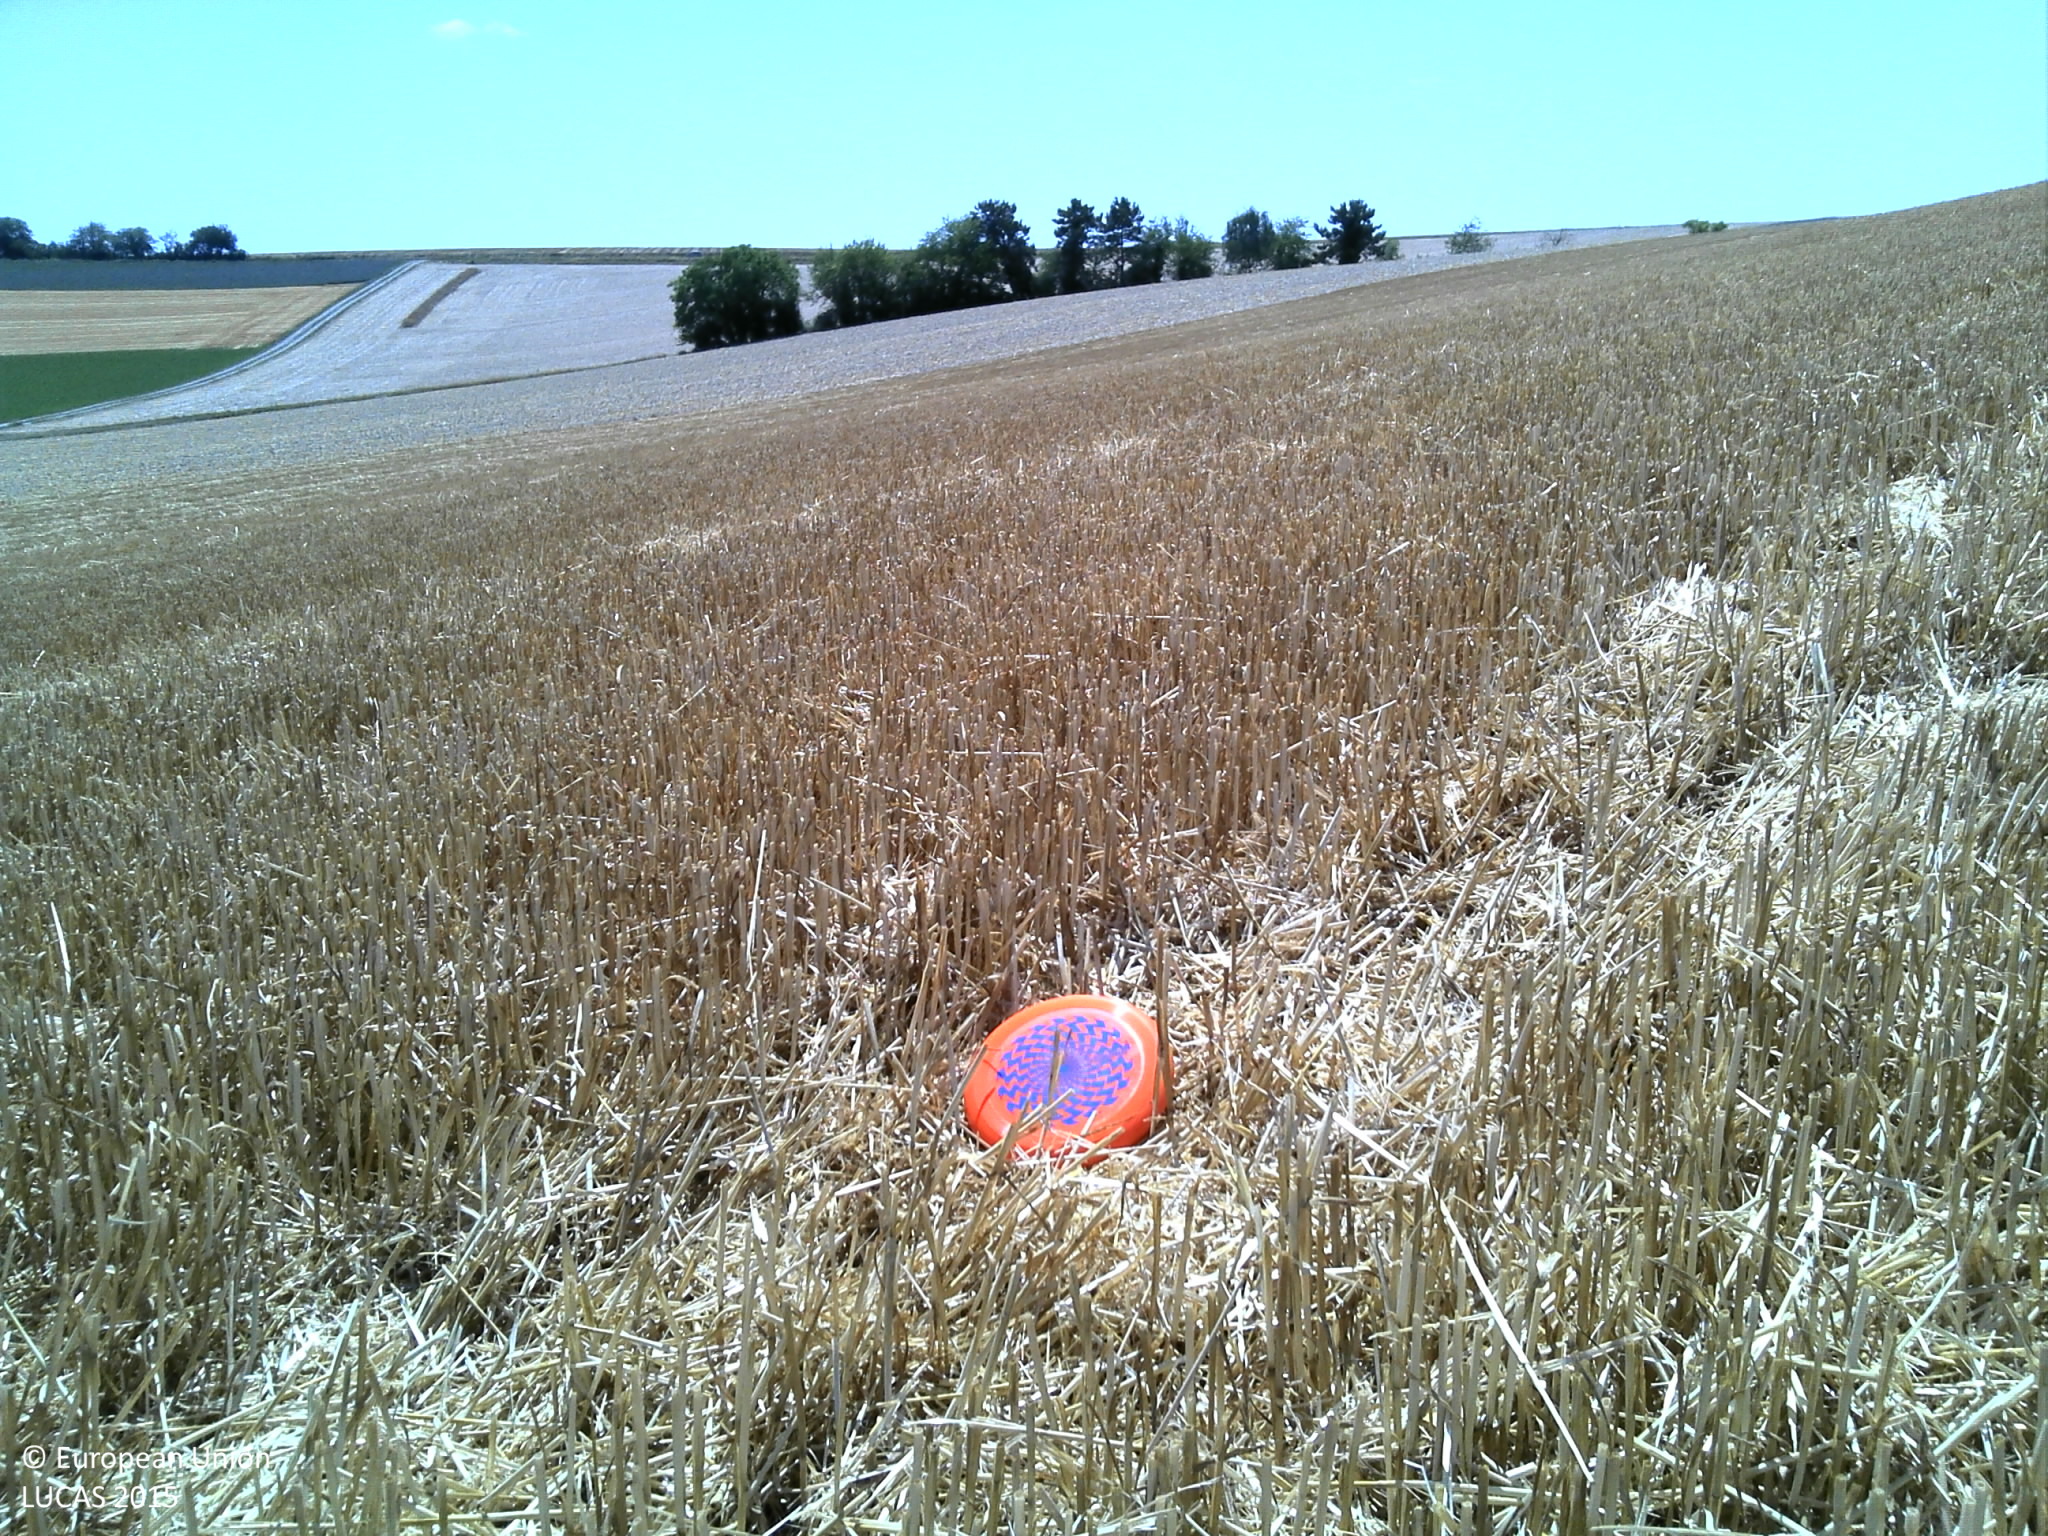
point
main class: Cropland
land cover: Common wheat
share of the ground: > 75 %
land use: Agriculture (excluding fallow land and kitchen gardens)
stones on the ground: < 10 %
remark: Harvested field
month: July
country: FR
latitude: 48.8724
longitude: 4.7210
